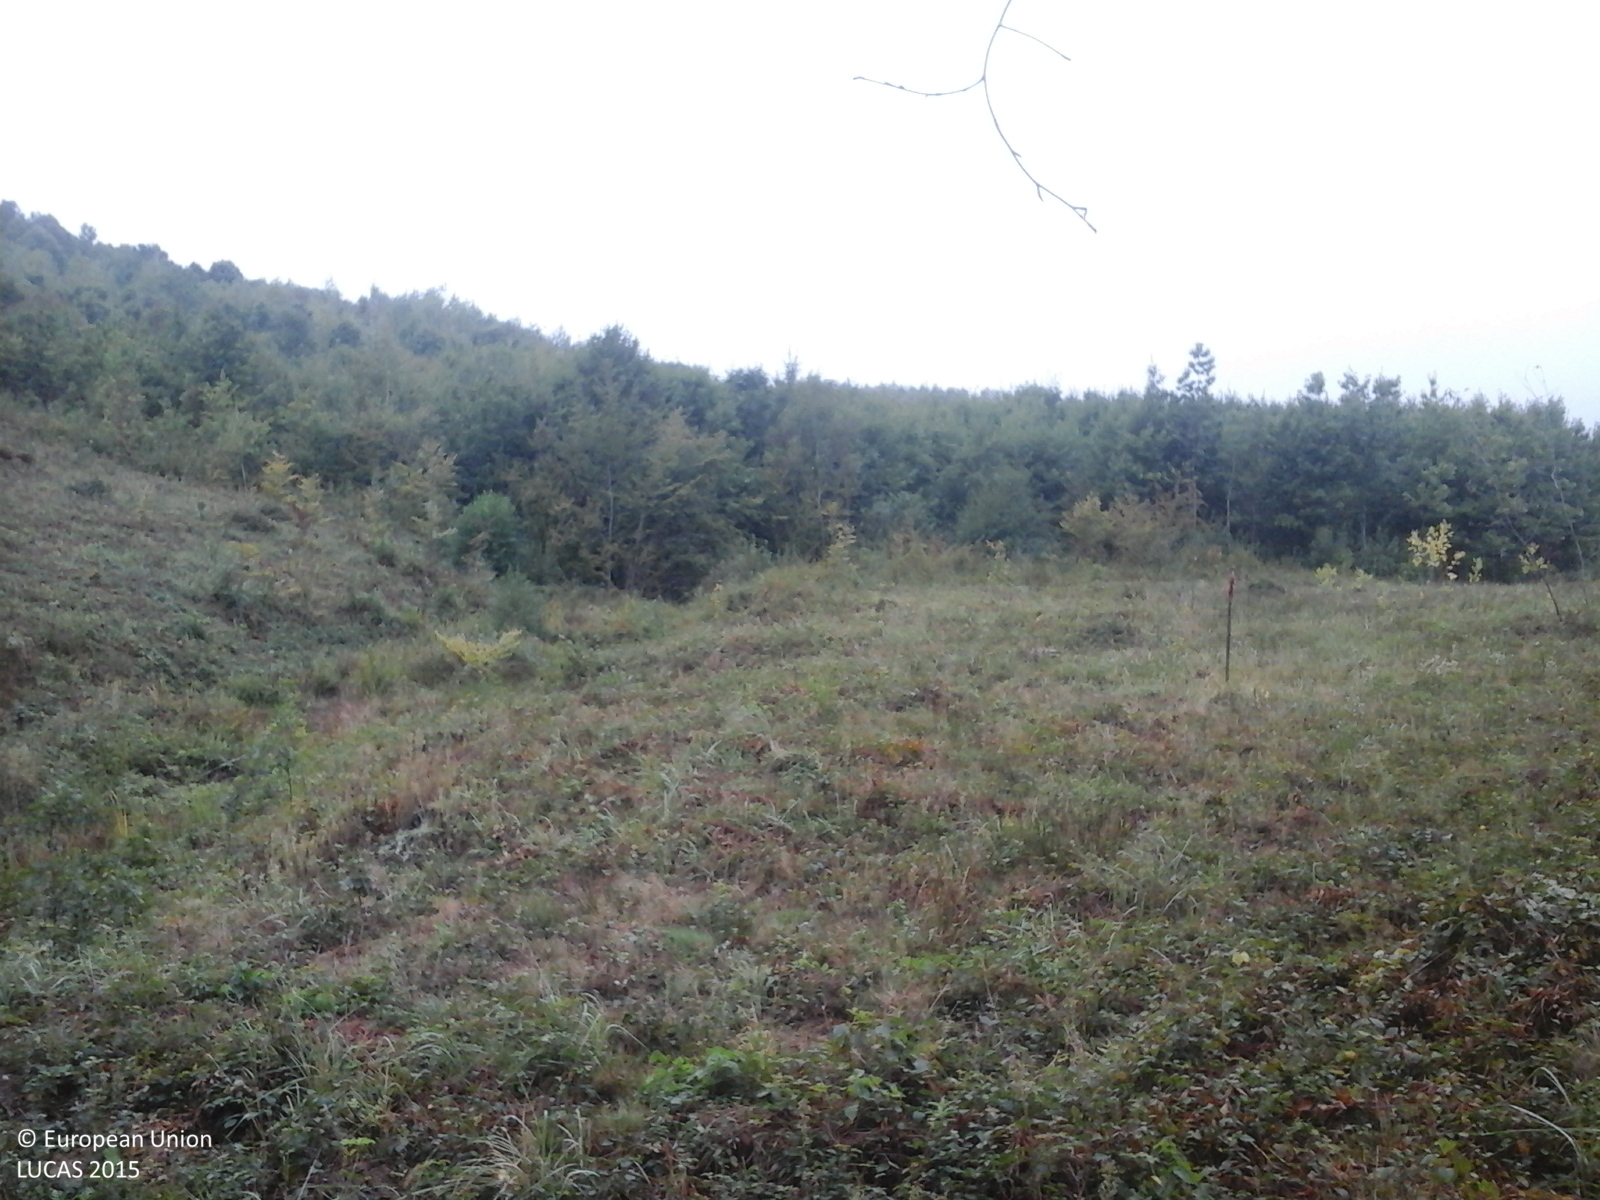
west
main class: Shrubland
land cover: Shrubland without tree cover
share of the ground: > 75 %
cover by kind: shrubs 100 %
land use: Forestry
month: September
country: RO
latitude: 45.7600
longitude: 22.1925
